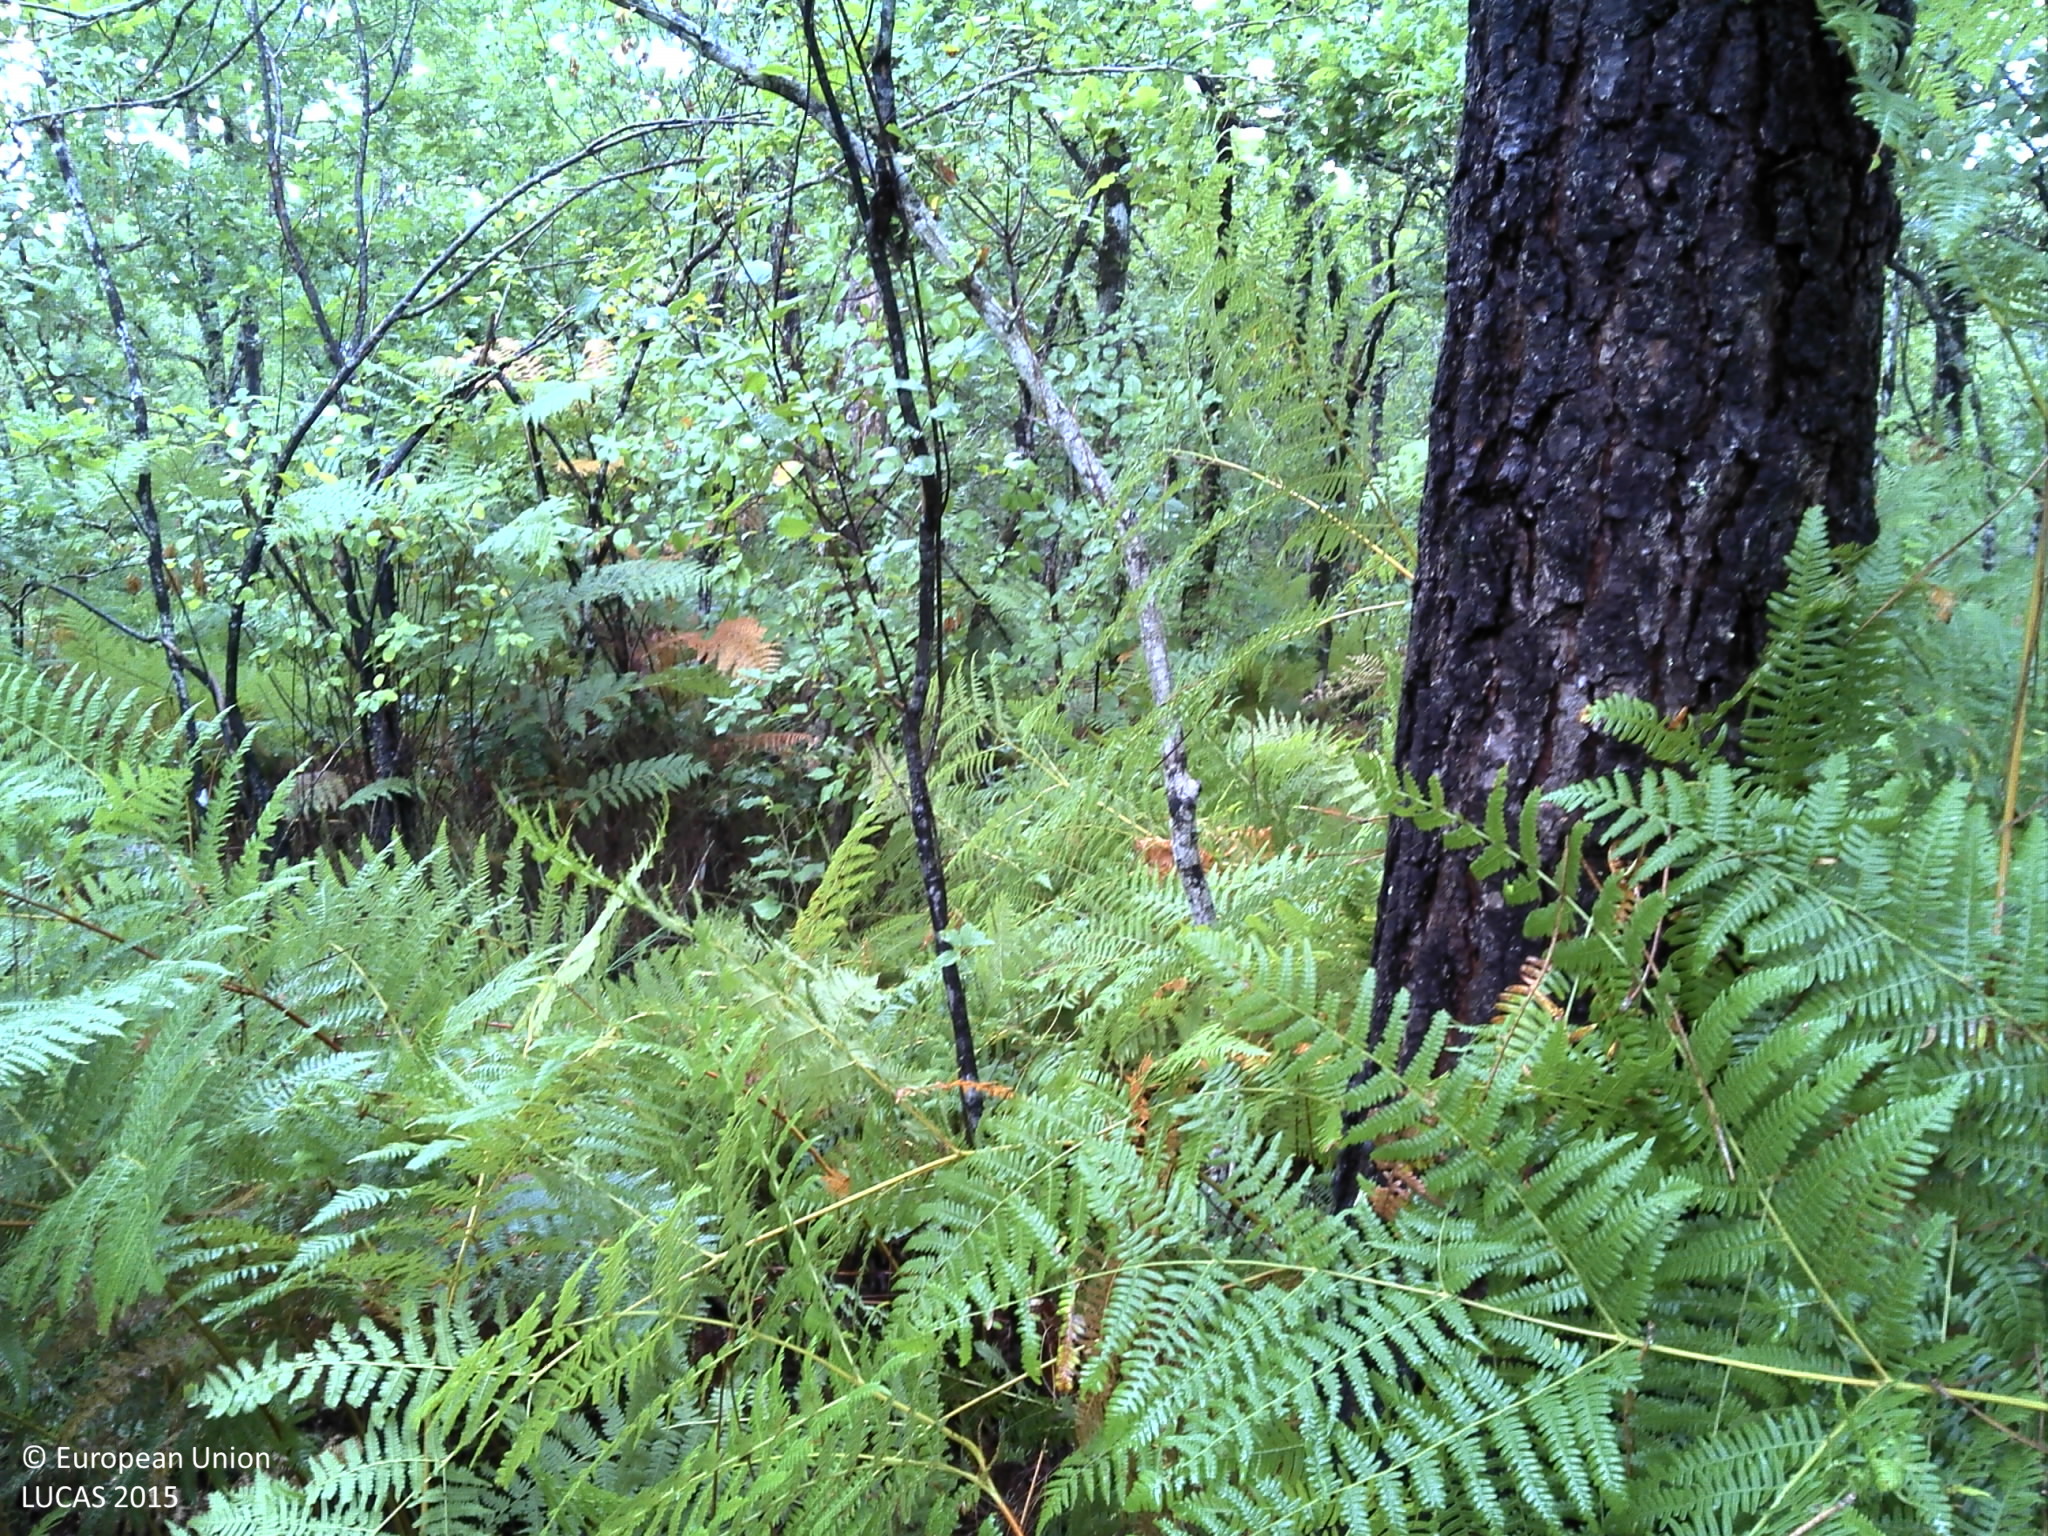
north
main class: Woodland
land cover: Pine dominated mixed woodland
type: coniferous forest of the mediterranean region
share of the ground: > 75 %
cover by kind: broadleaved forest trees 40 %, shrubs 30 %, coniferous forest trees 20 %, herbaceous plants 10 %
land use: Forestry
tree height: > 5 m
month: August
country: FR
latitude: 45.2105
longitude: -0.5503
